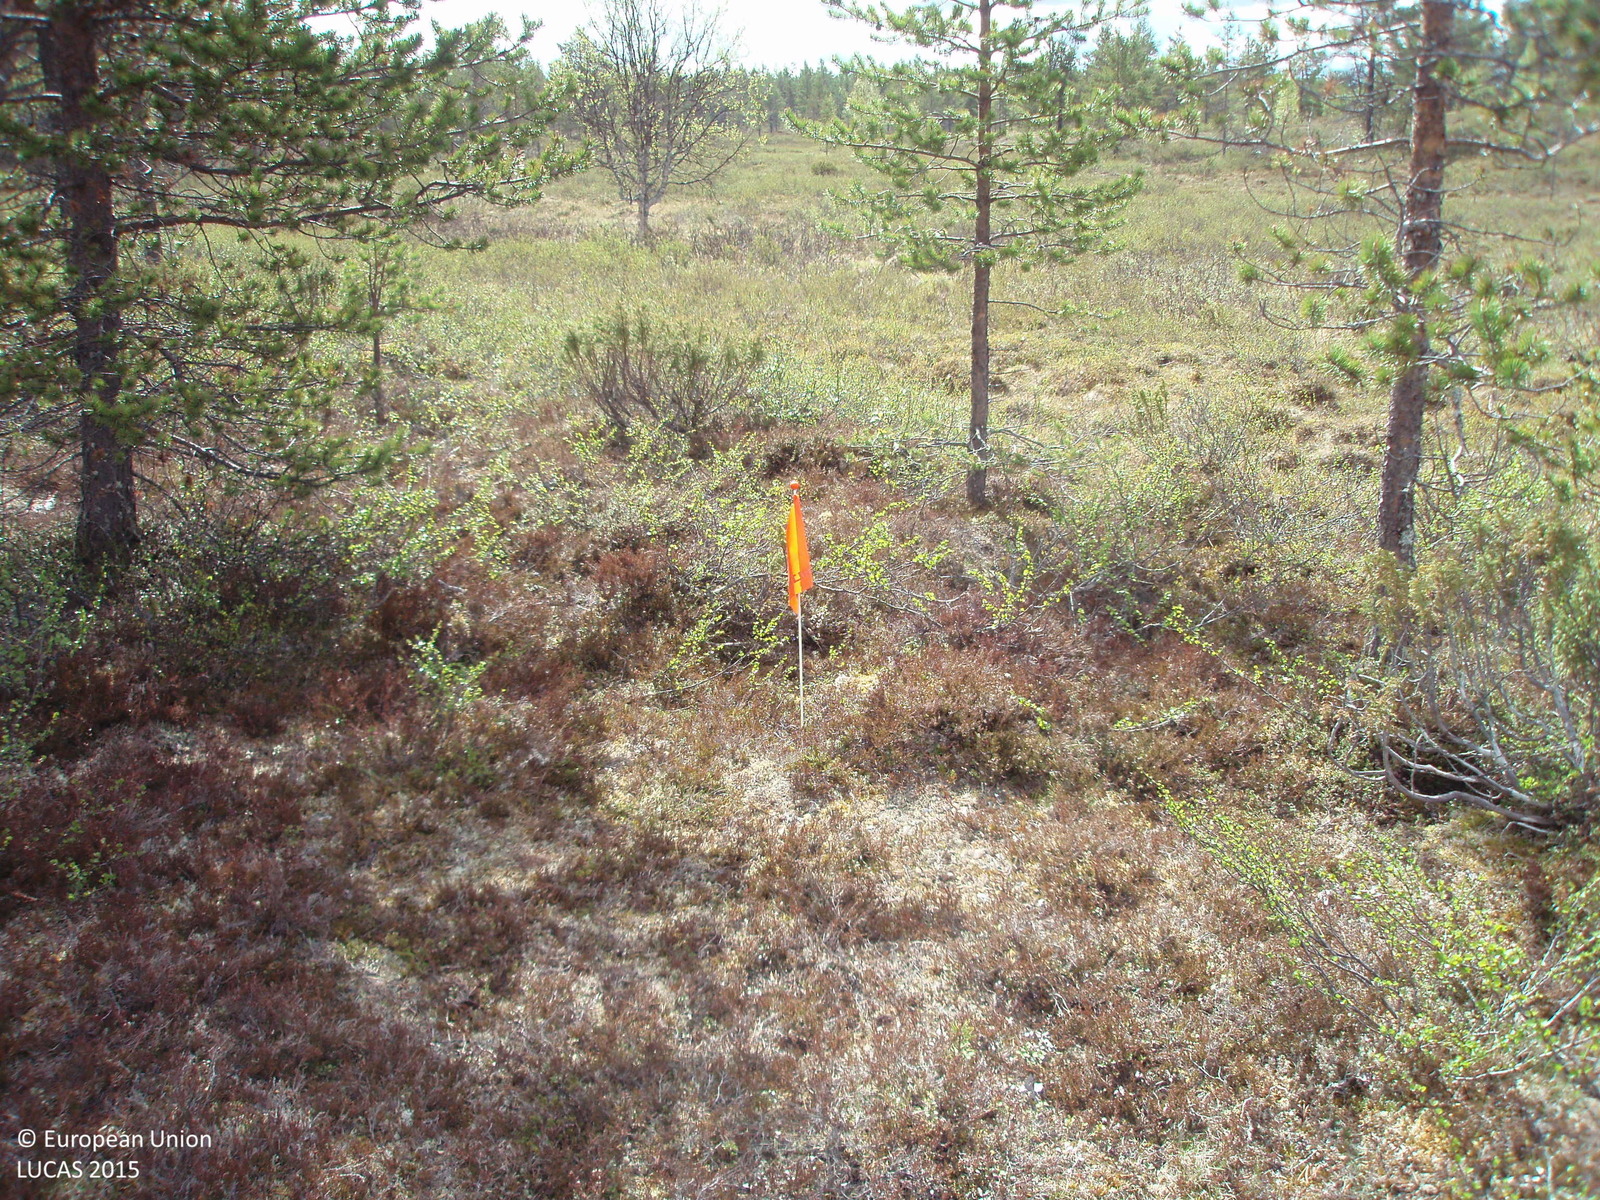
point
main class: Shrubland
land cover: Shrubland with sparse tree cover
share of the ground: > 75 %
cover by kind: shrubs 75 %, lichens and mosses 20 %, coniferous forest trees 5 %
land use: Semi-natural and natural areas not in use
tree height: > 5 m
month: June
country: FI
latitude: 68.3950
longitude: 26.9318
